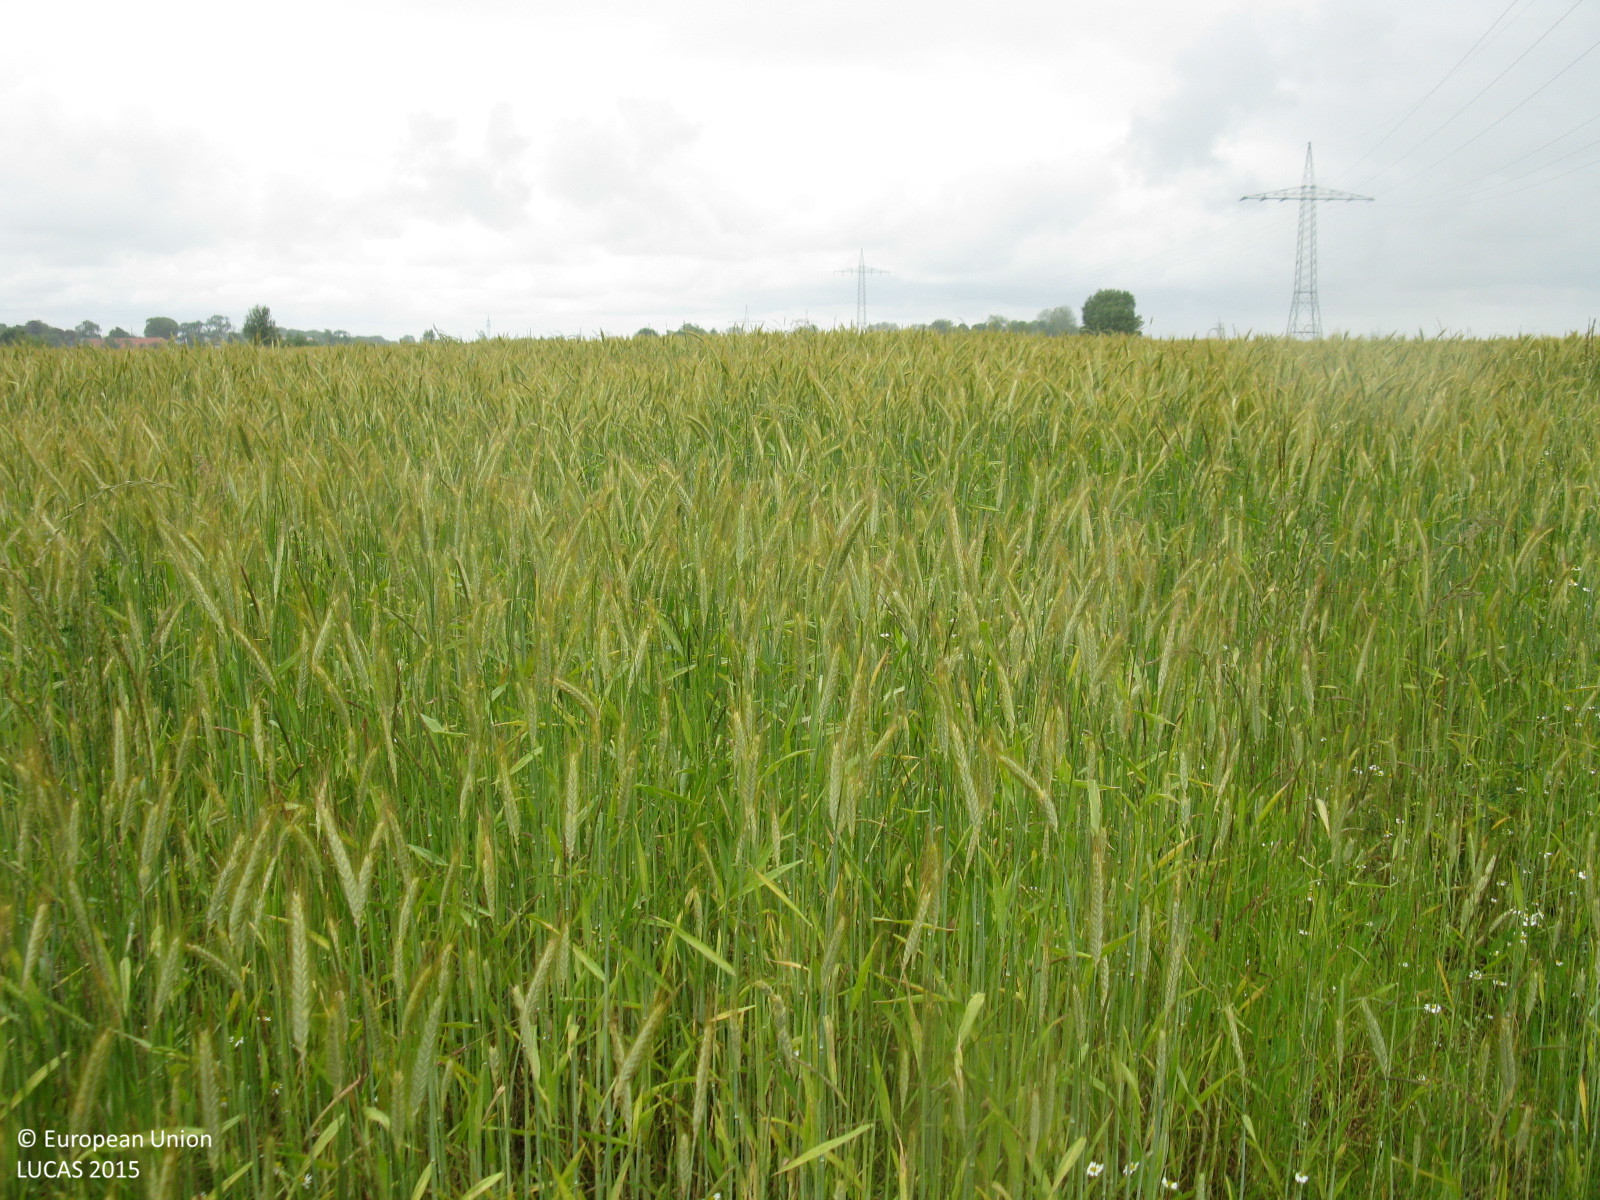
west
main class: Cropland
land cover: Triticale
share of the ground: > 75 %
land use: Agriculture (excluding fallow land and kitchen gardens)
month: June
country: DE
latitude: 53.6724
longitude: 7.9573
